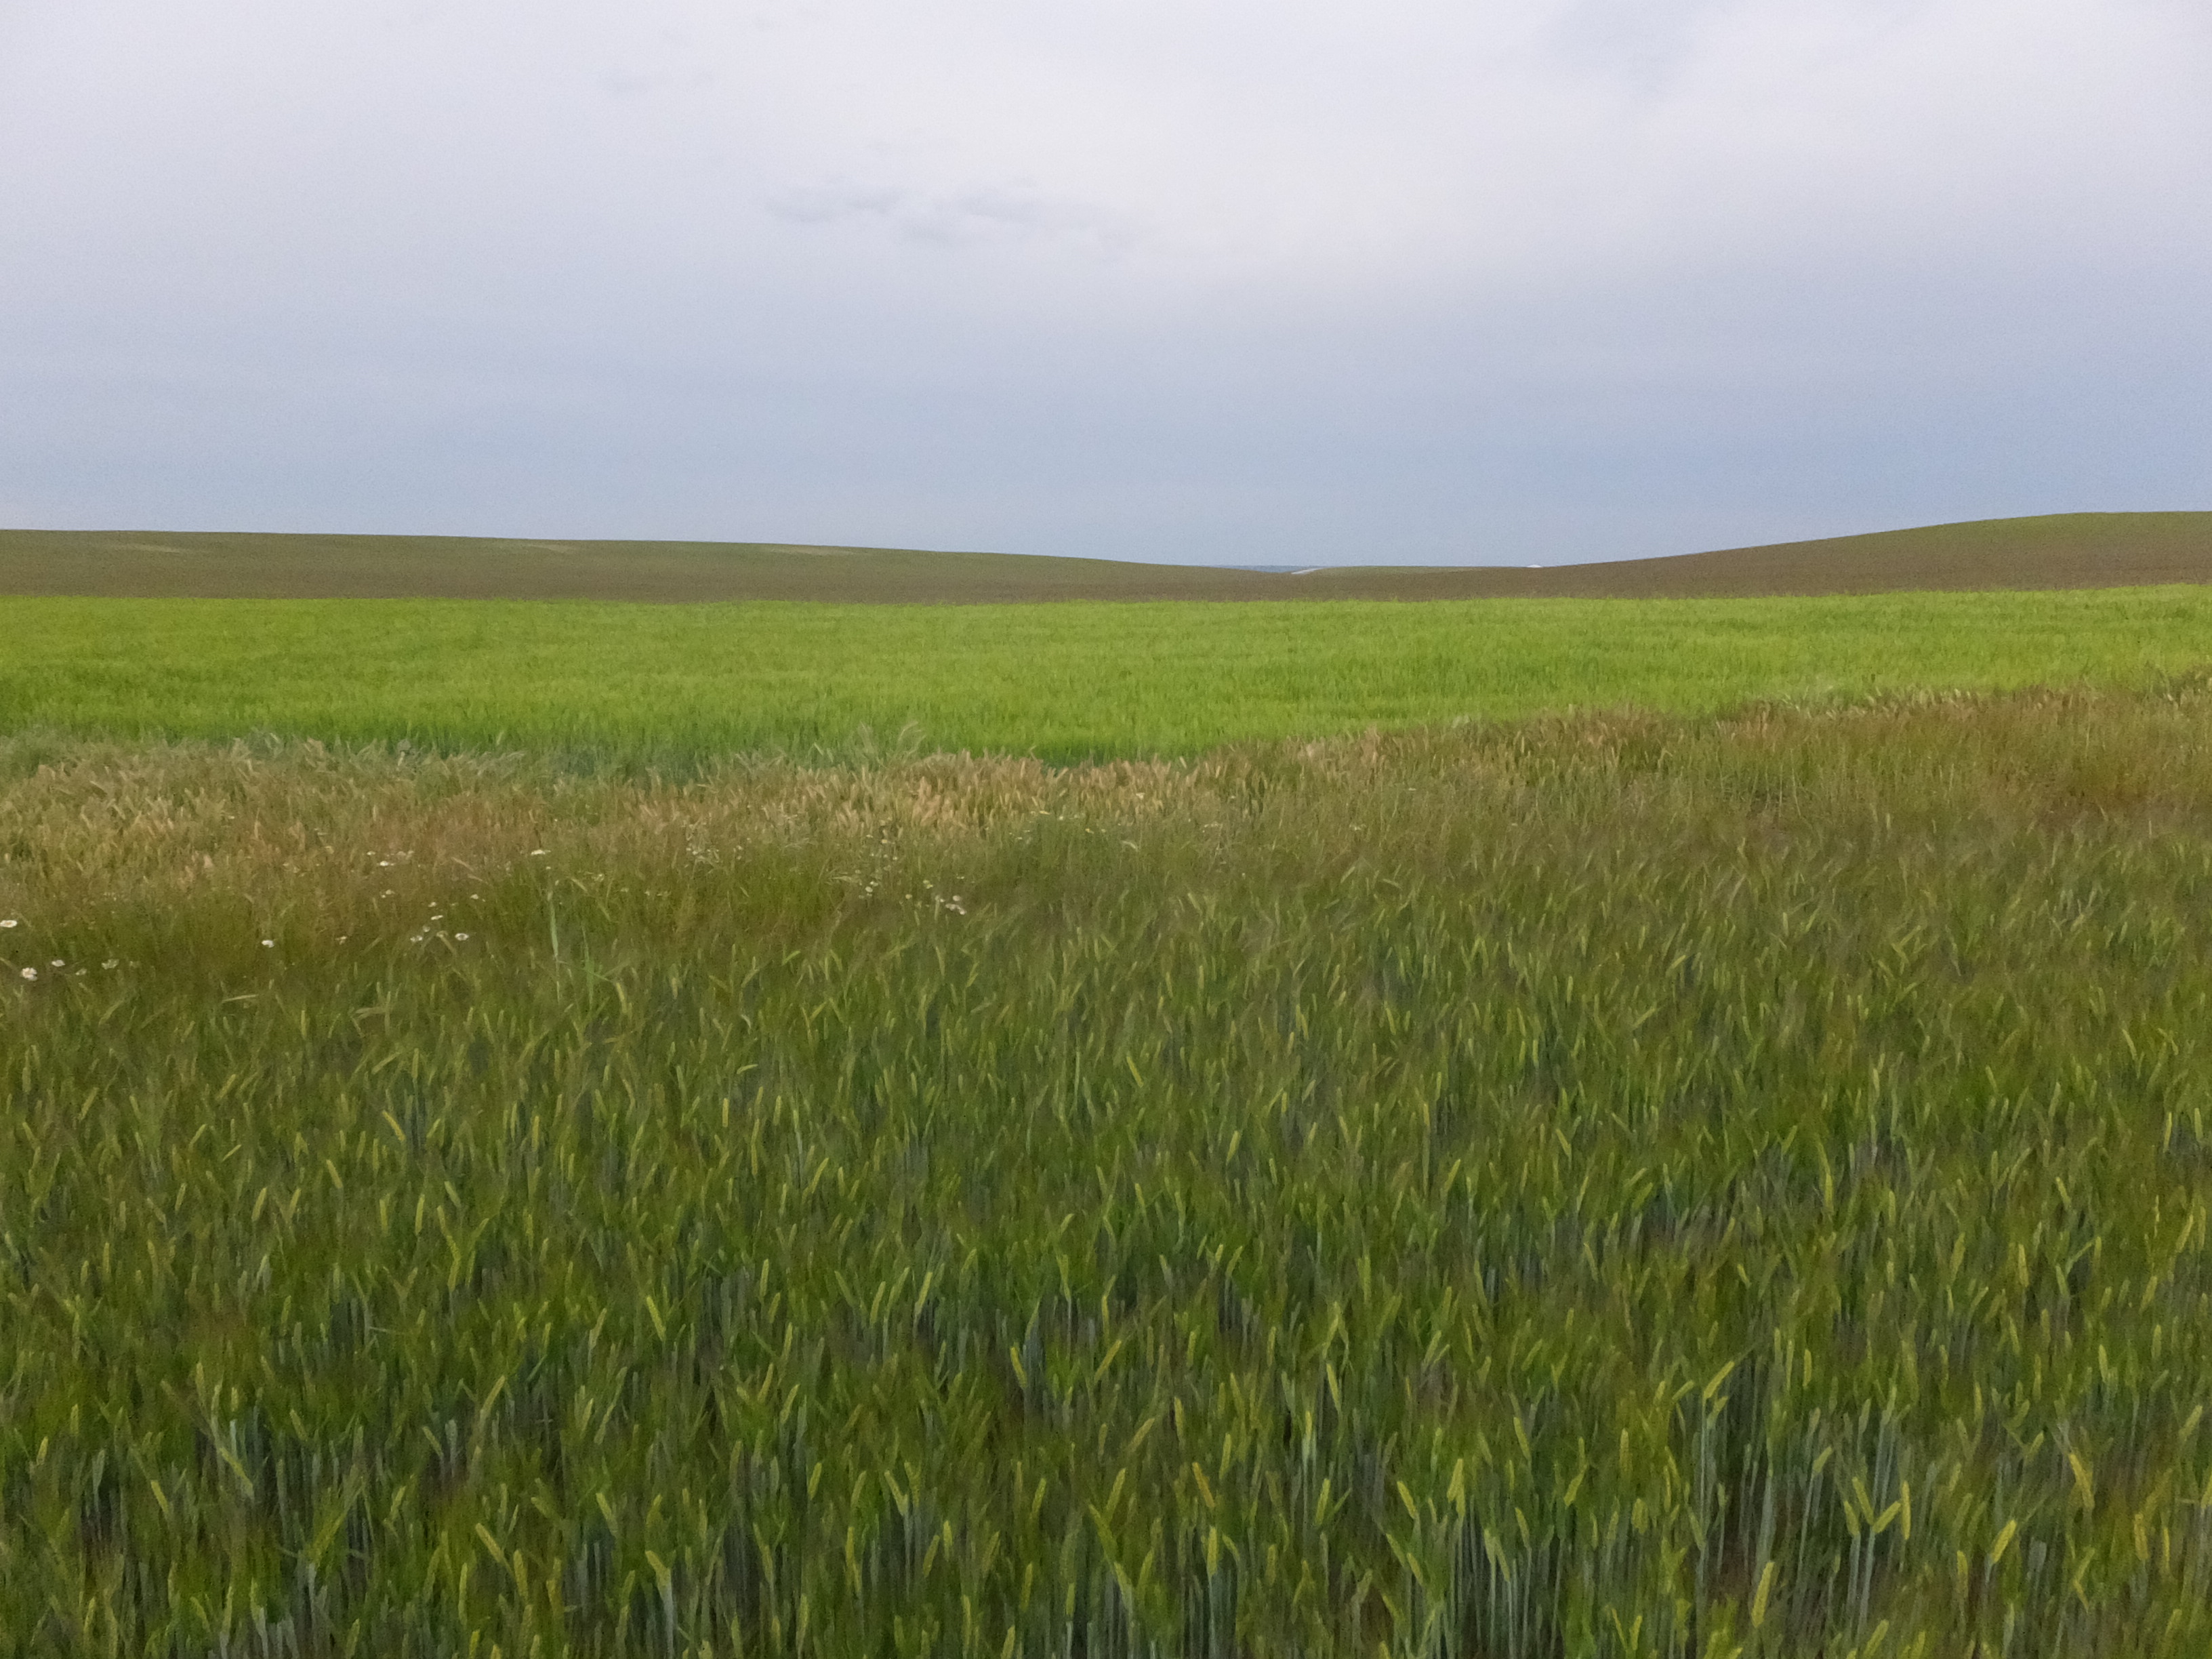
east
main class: Cropland
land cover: Barley
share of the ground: > 75 %
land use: Agriculture (excluding fallow land and kitchen gardens)
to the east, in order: Barley; Grass margins; Barley; Grass margins; Barley
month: April
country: ES
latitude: 41.6121
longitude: -0.1808
